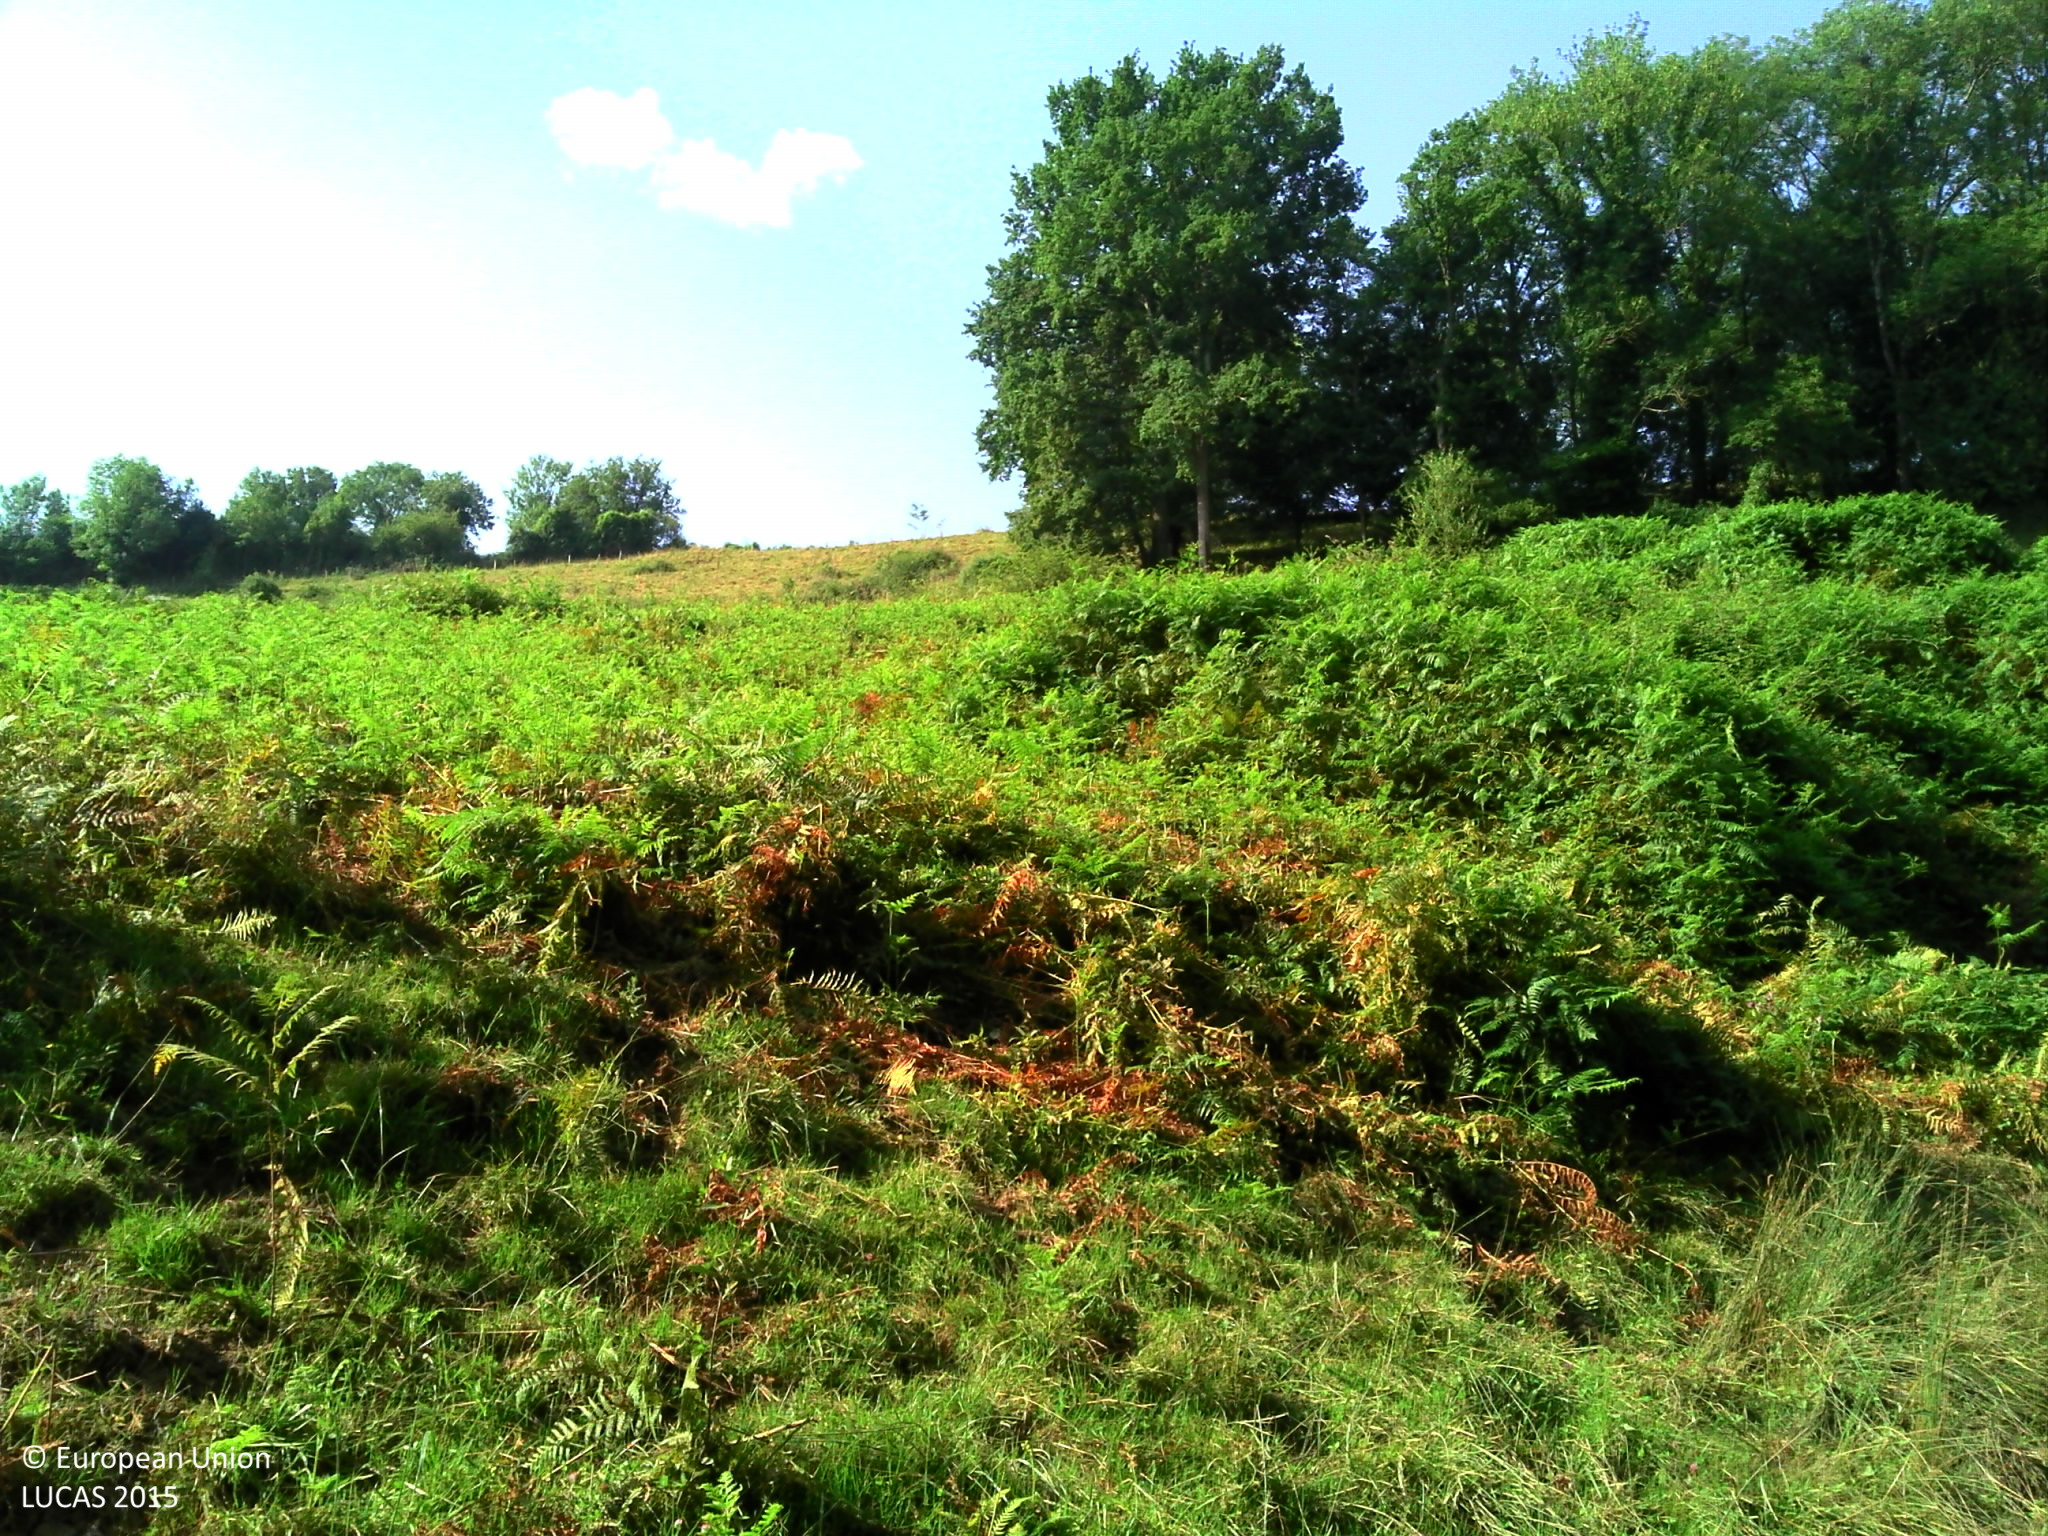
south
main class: Grassland
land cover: Spontaneously vegetated surfaces
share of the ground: > 75 %
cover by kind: herbaceous plants 100 %
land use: Agriculture (excluding fallow land and kitchen gardens)
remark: Temporary dry
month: July
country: FR
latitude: 43.0047
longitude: 1.0858
